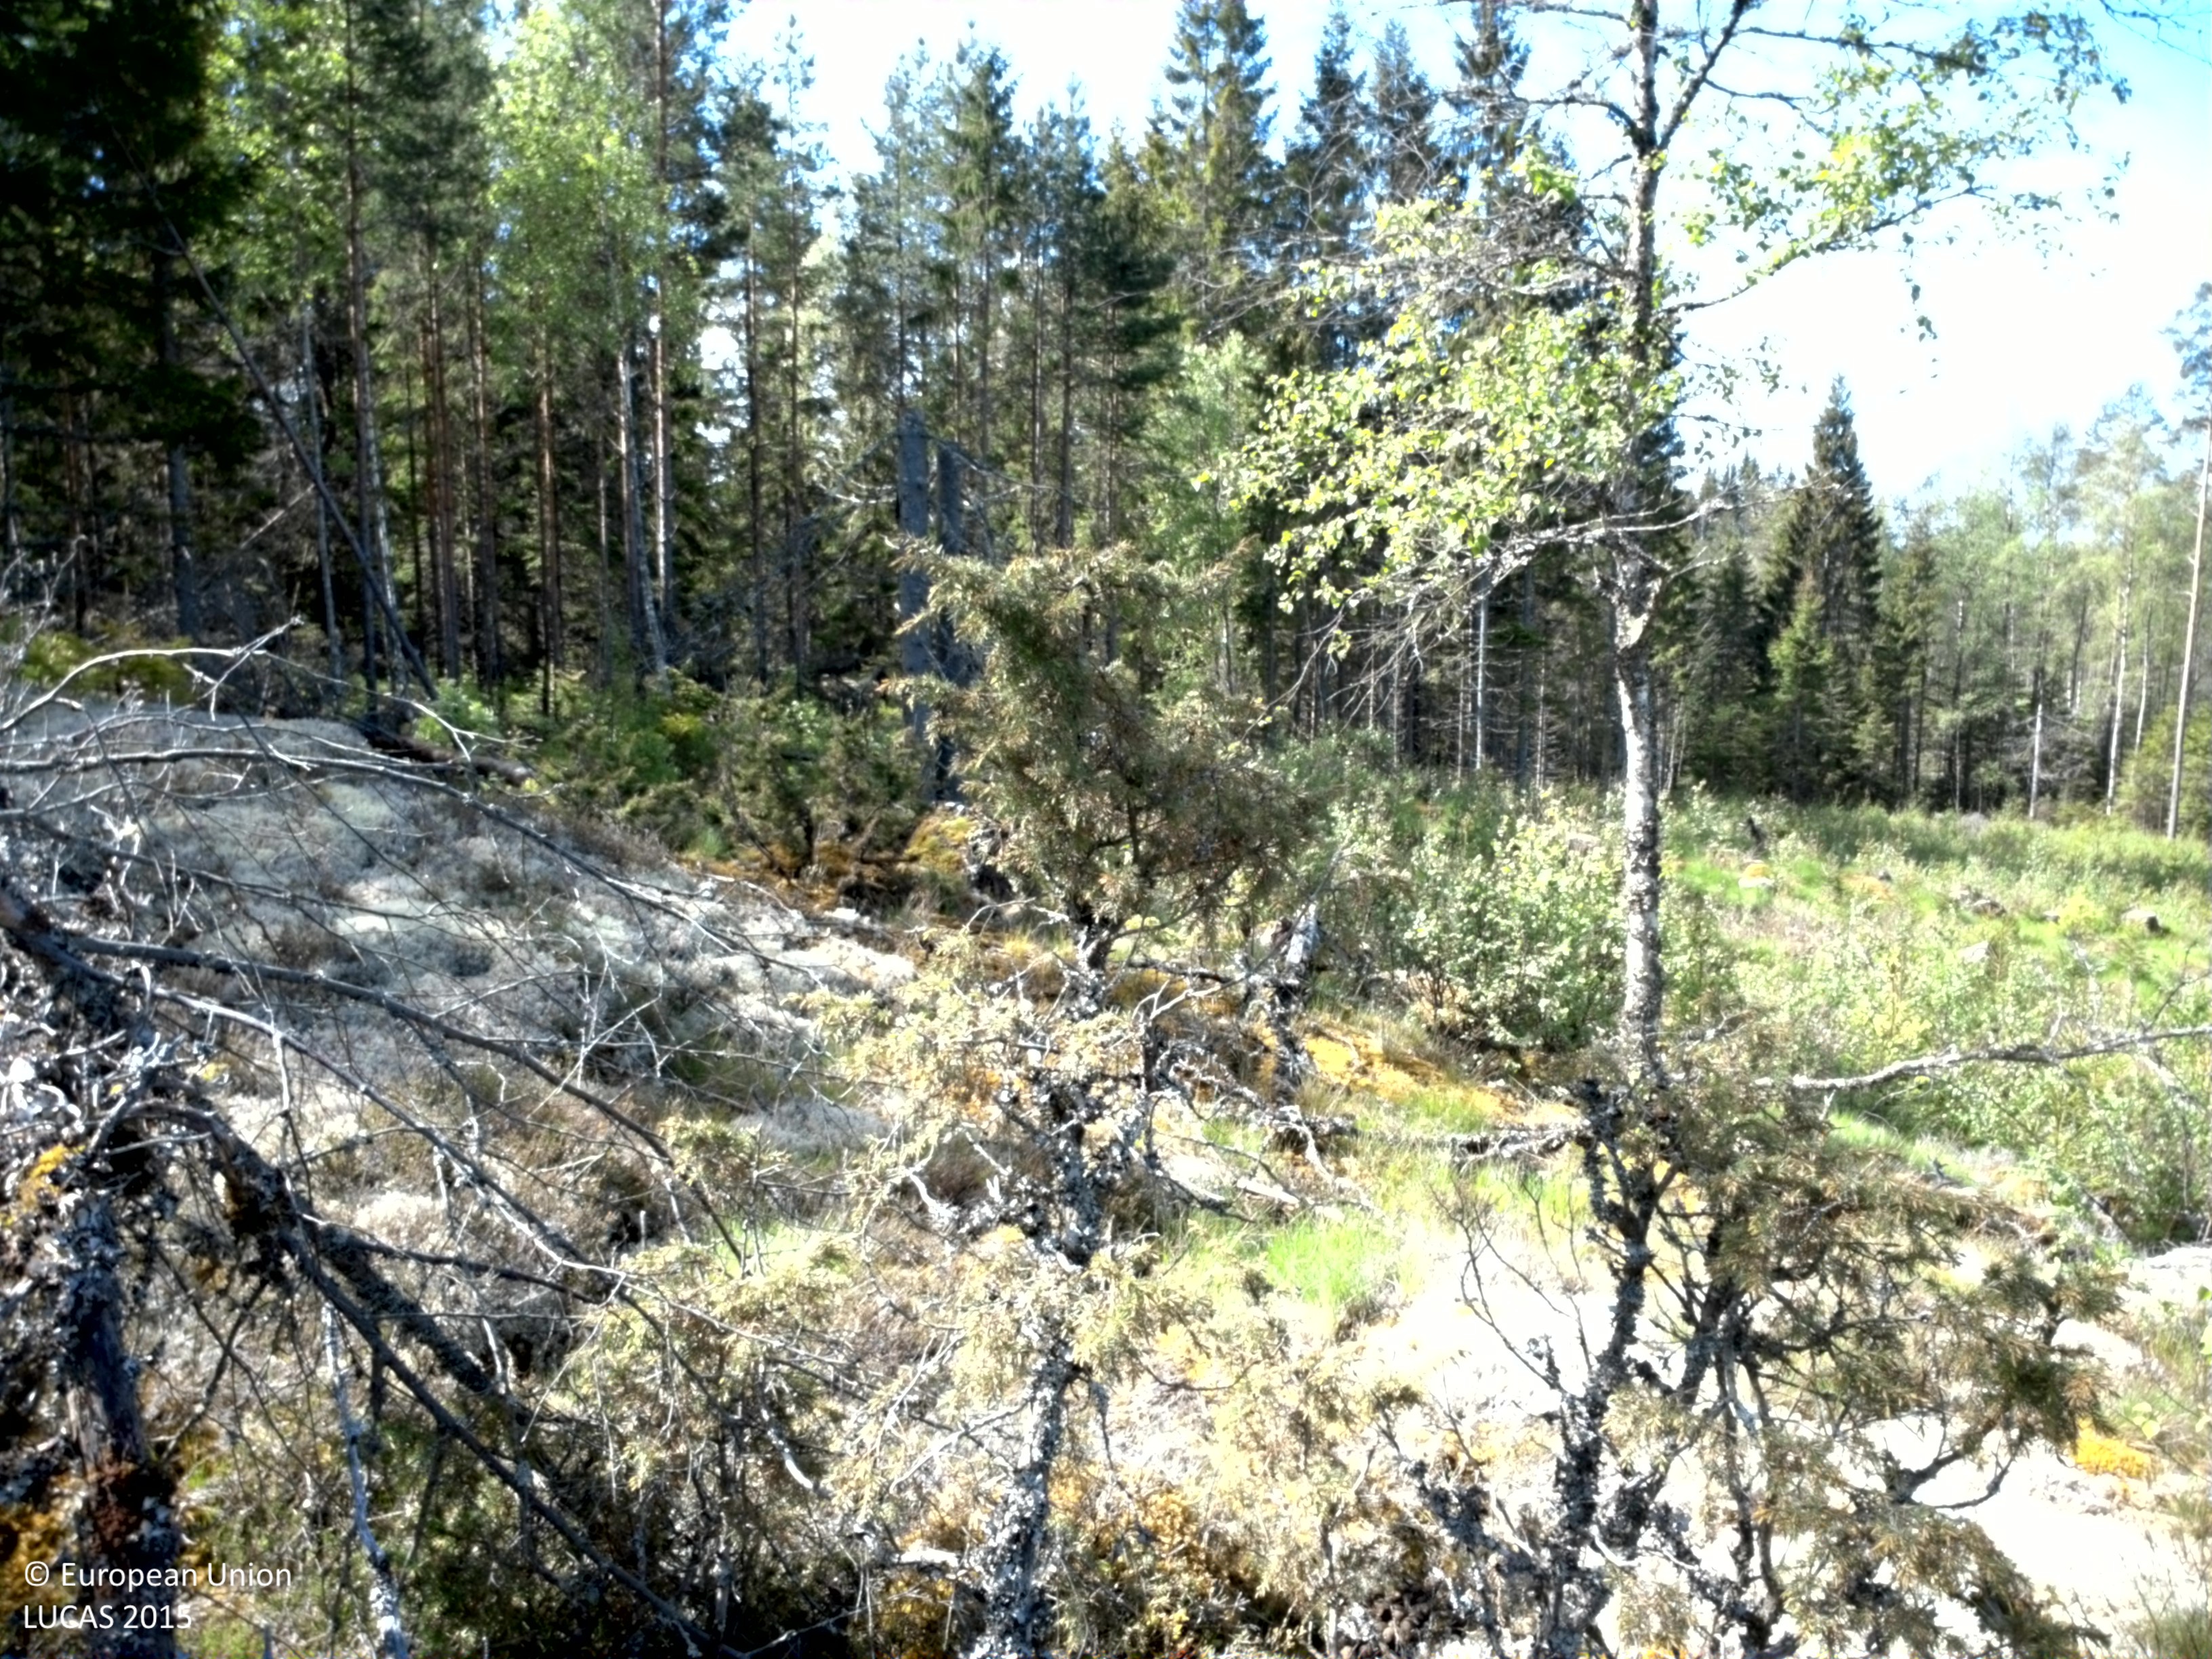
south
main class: Shrubland
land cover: Shrubland with sparse tree cover
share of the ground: 50 - 75 %
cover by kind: shrubs 50 %, lichens and mosses 25 %, herbaceous plants 20 %, coniferous forest trees 5 %
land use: Forestry
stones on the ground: 25 - 50 %
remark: Clear cut
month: June
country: SE
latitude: 59.3325
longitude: 12.3671
